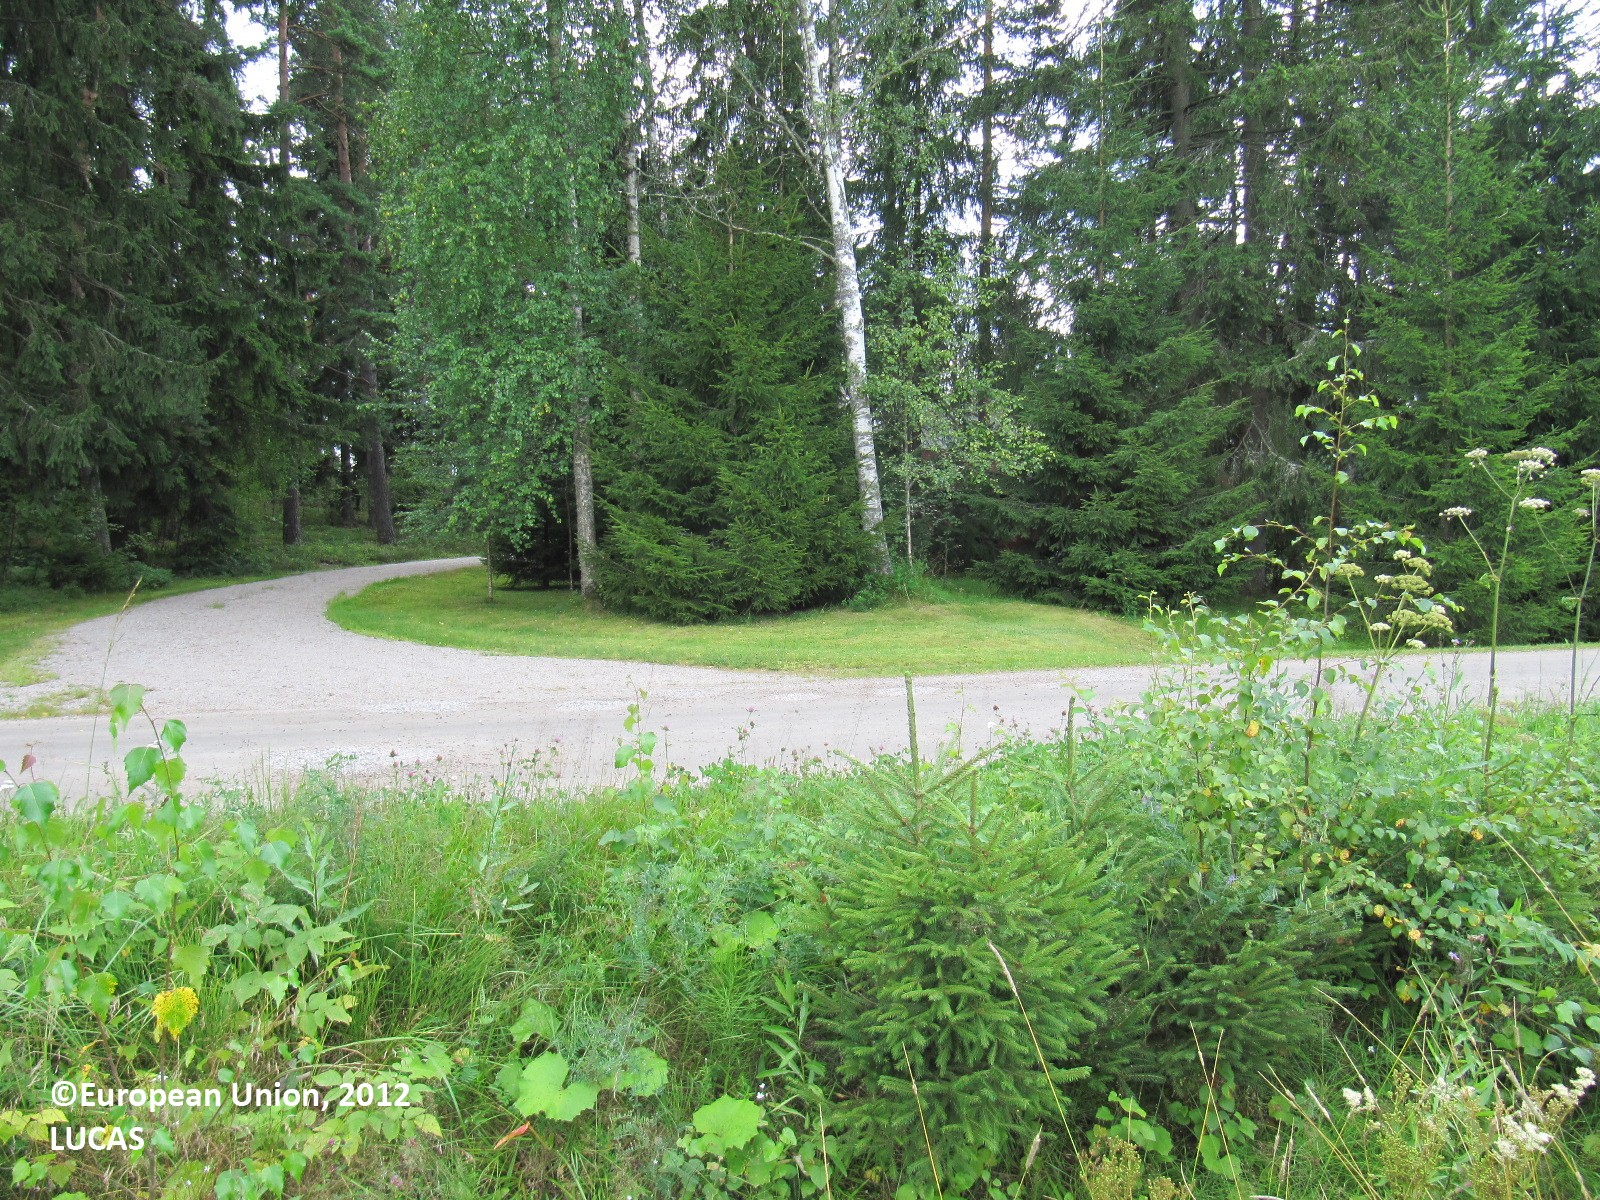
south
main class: Cropland
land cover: Rape and turnip rape
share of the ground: > 75 %
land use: Agriculture (excluding fallow land and kitchen gardens)
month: August
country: FI
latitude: 60.4155
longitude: 23.2106
